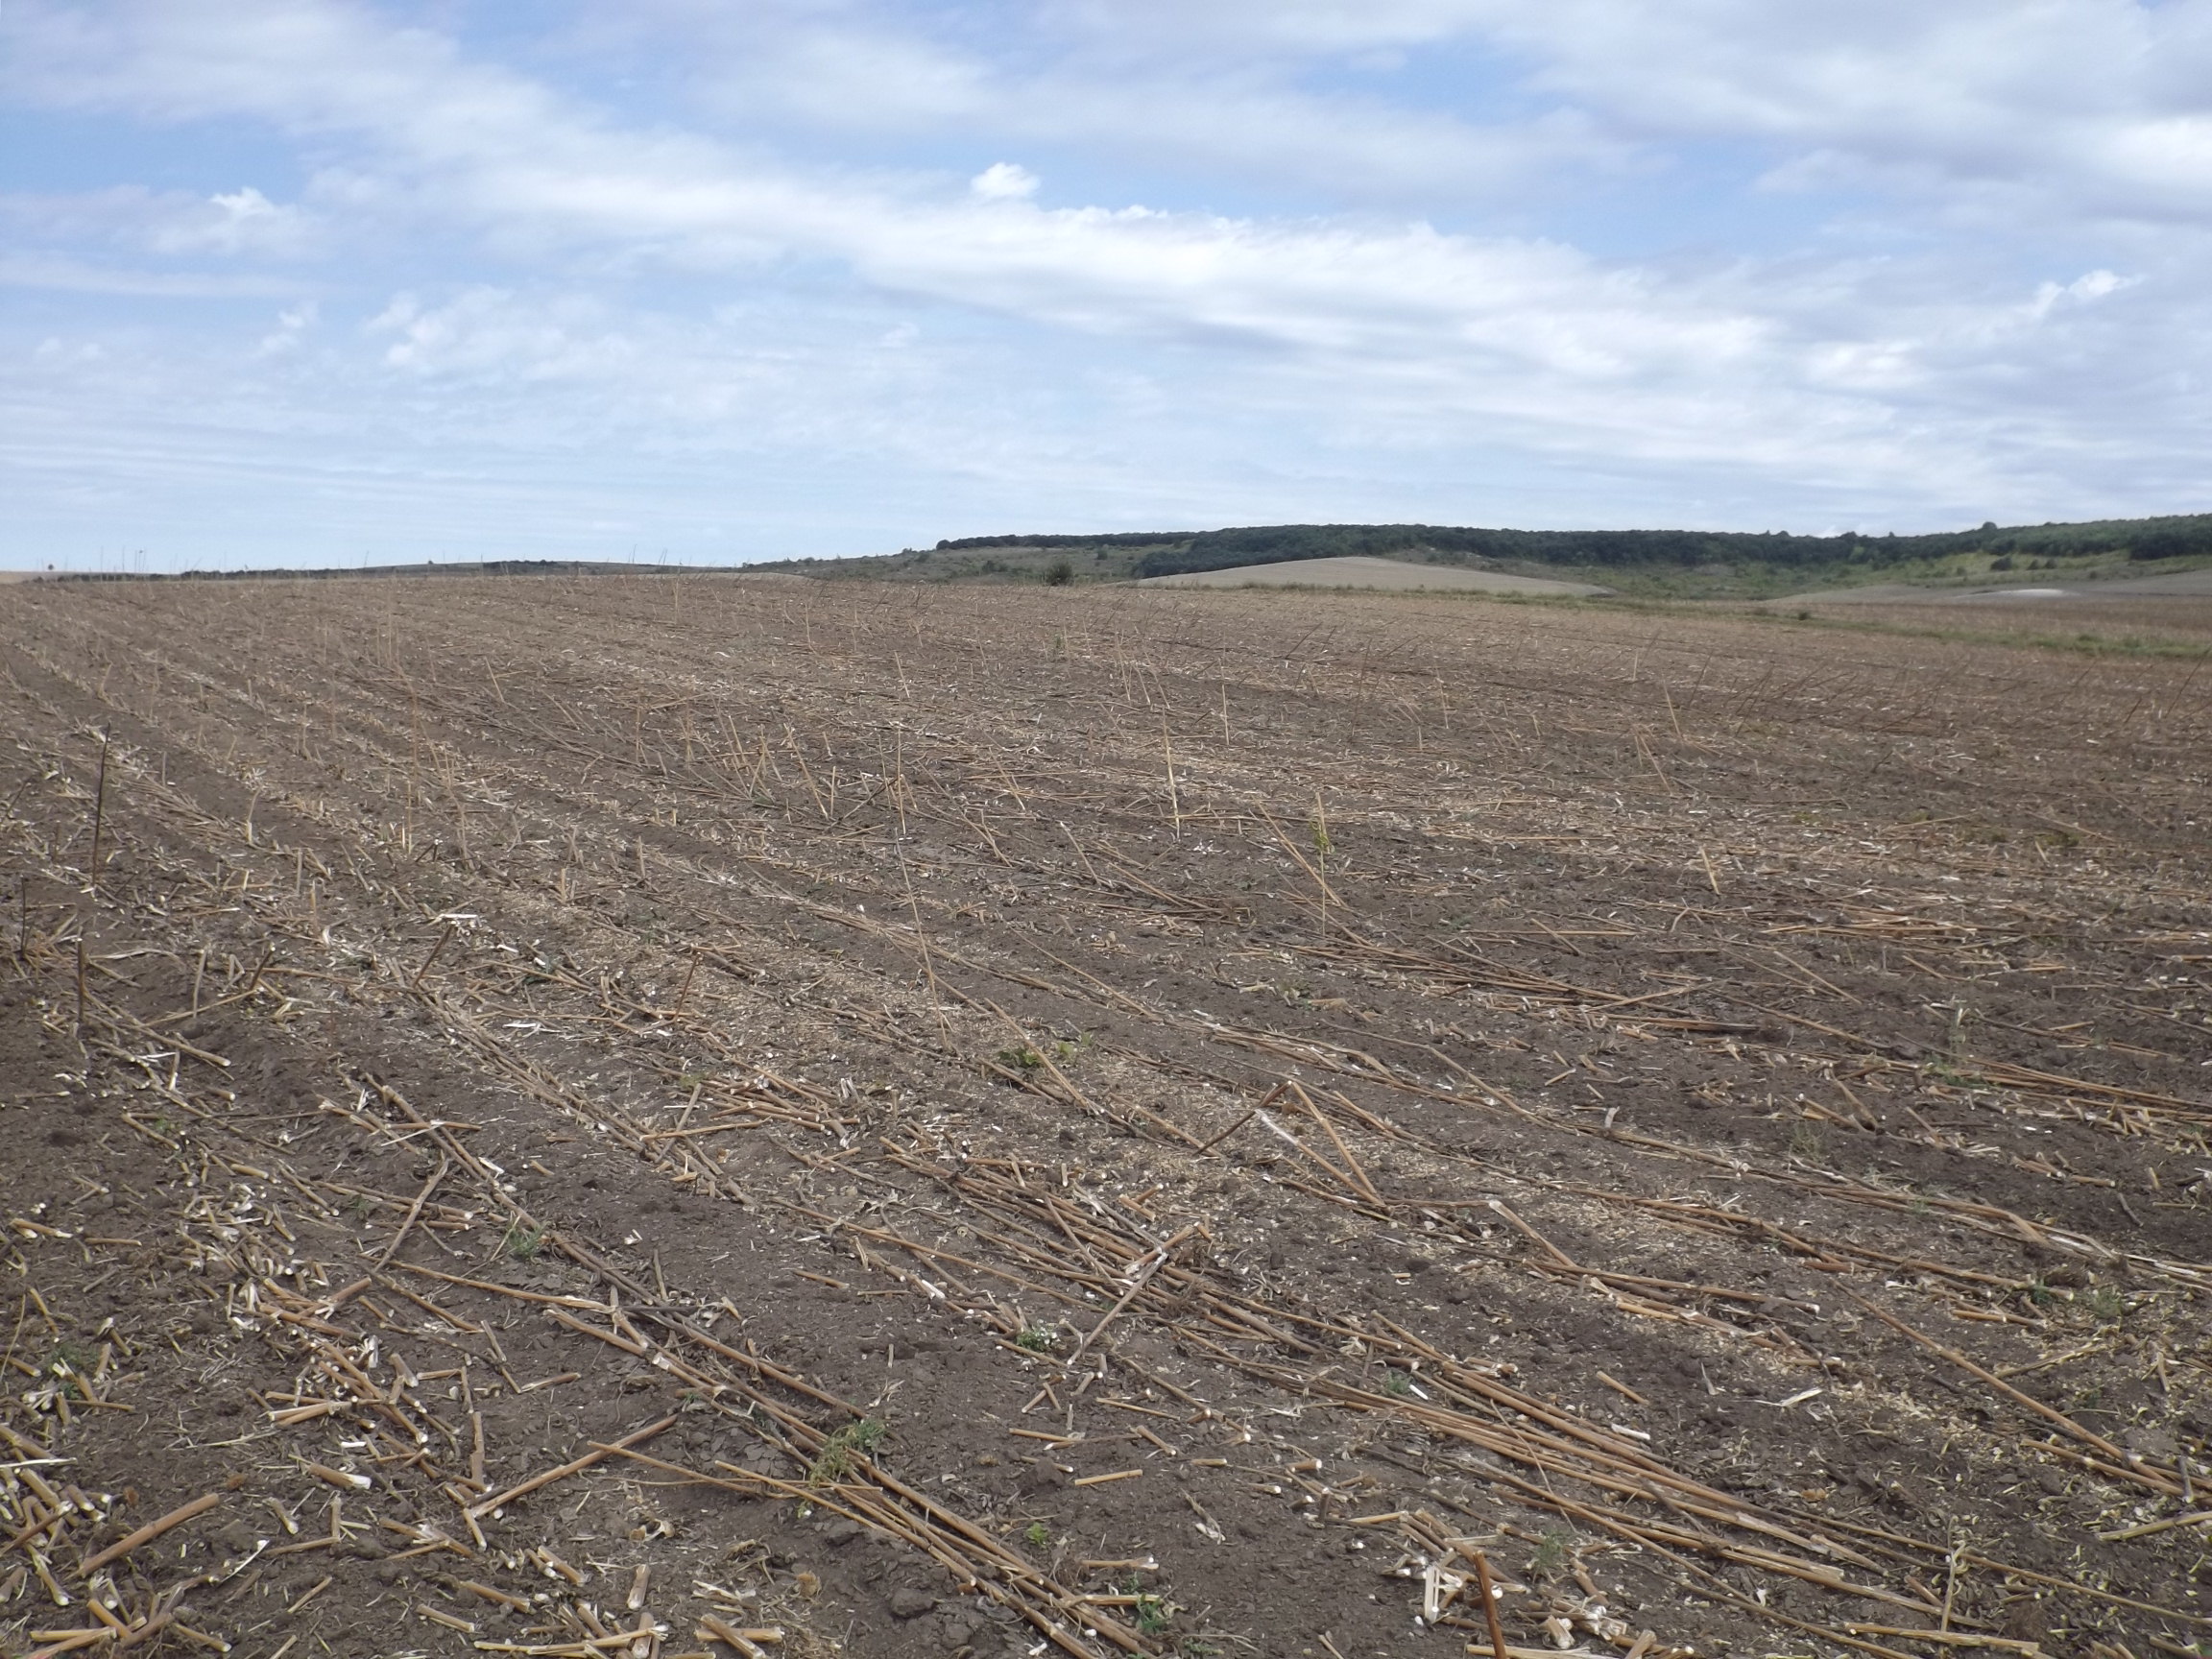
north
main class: Cropland
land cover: Sunflower
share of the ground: < 10 %
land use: Agriculture (excluding fallow land and kitchen gardens)
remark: Harvested field
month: September
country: BG
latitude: 43.3740
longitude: 27.3419
